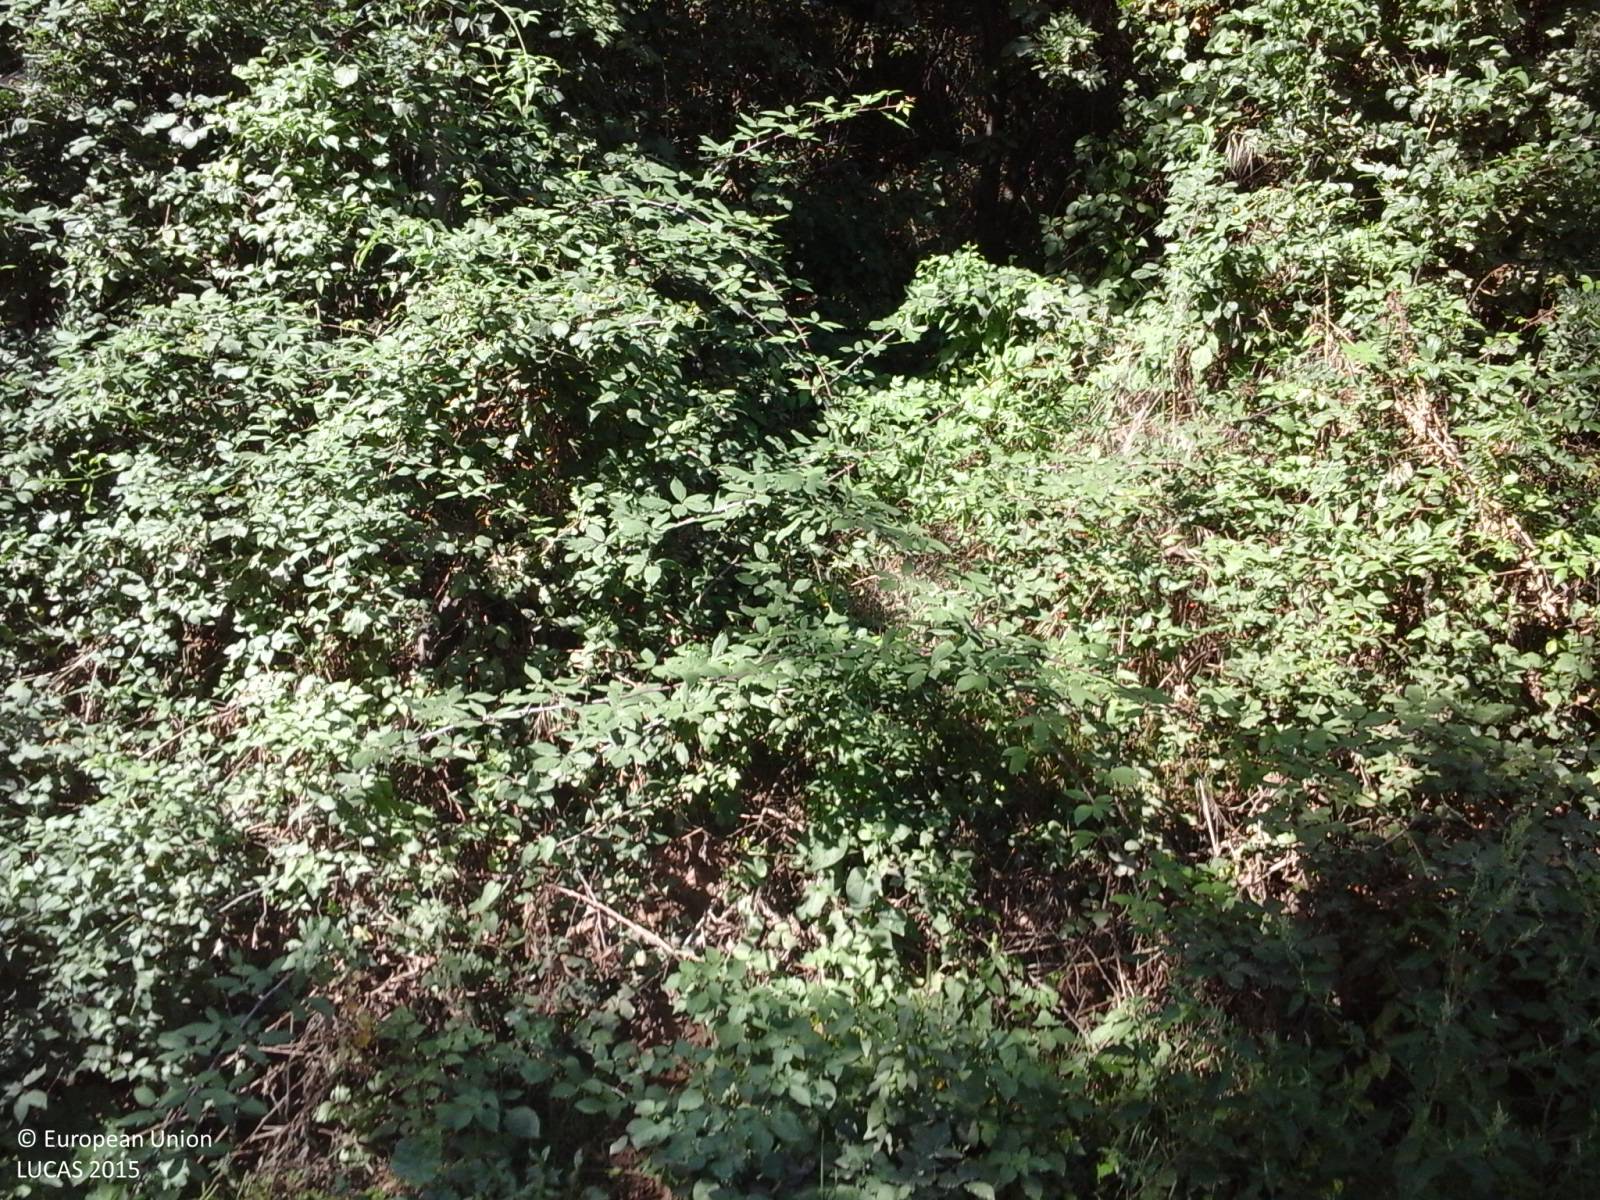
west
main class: Woodland
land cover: Broadleaved woodland
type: thermophilous deciduous forest
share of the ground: > 75 %
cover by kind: broadleaved forest trees 75 %, shrubs 25 %
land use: Semi-natural and natural areas not in use
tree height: > 5 m
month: September
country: IT
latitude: 42.3577
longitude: 12.2626
